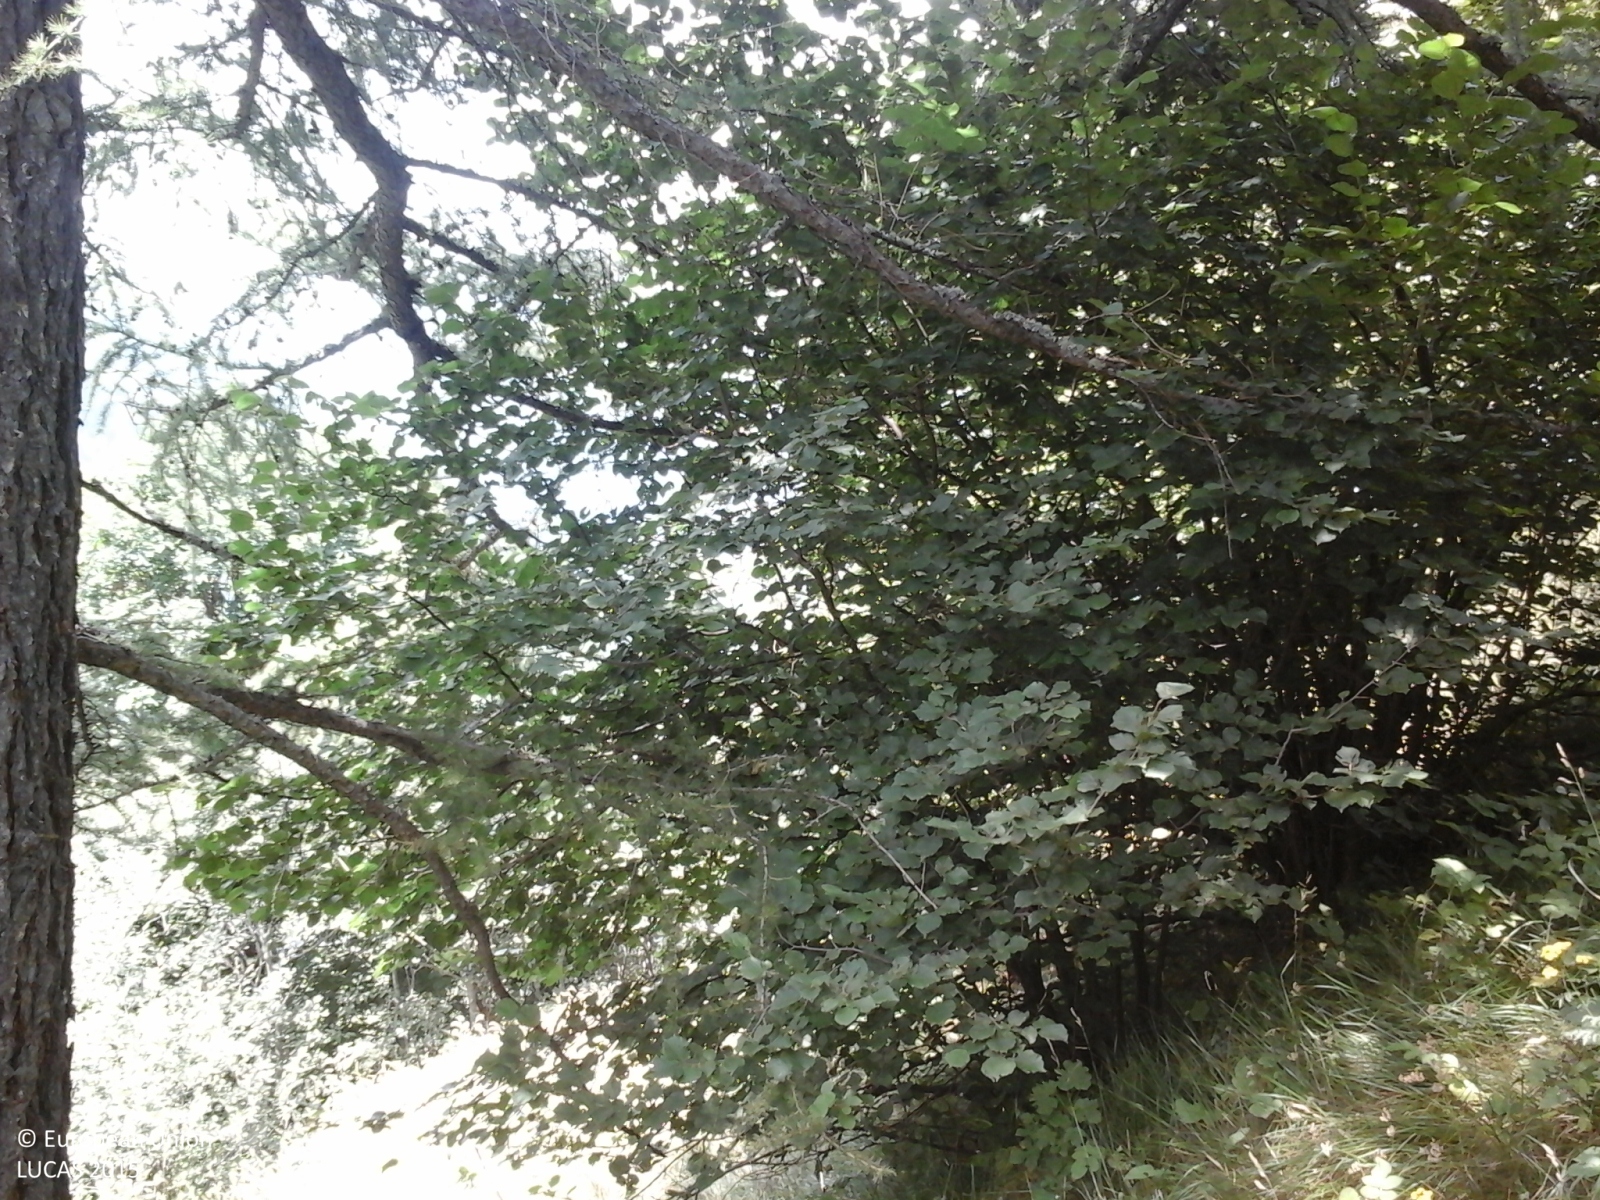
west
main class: Woodland
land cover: Other mixed woodland
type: mesophytic deciduous forest
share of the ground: > 75 %
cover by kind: broadleaved forest trees 75 %, coniferous forest trees 25 %
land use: Semi-natural and natural areas not in use
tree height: > 5 m
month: August
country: IT
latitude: 45.6789
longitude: 7.7566
